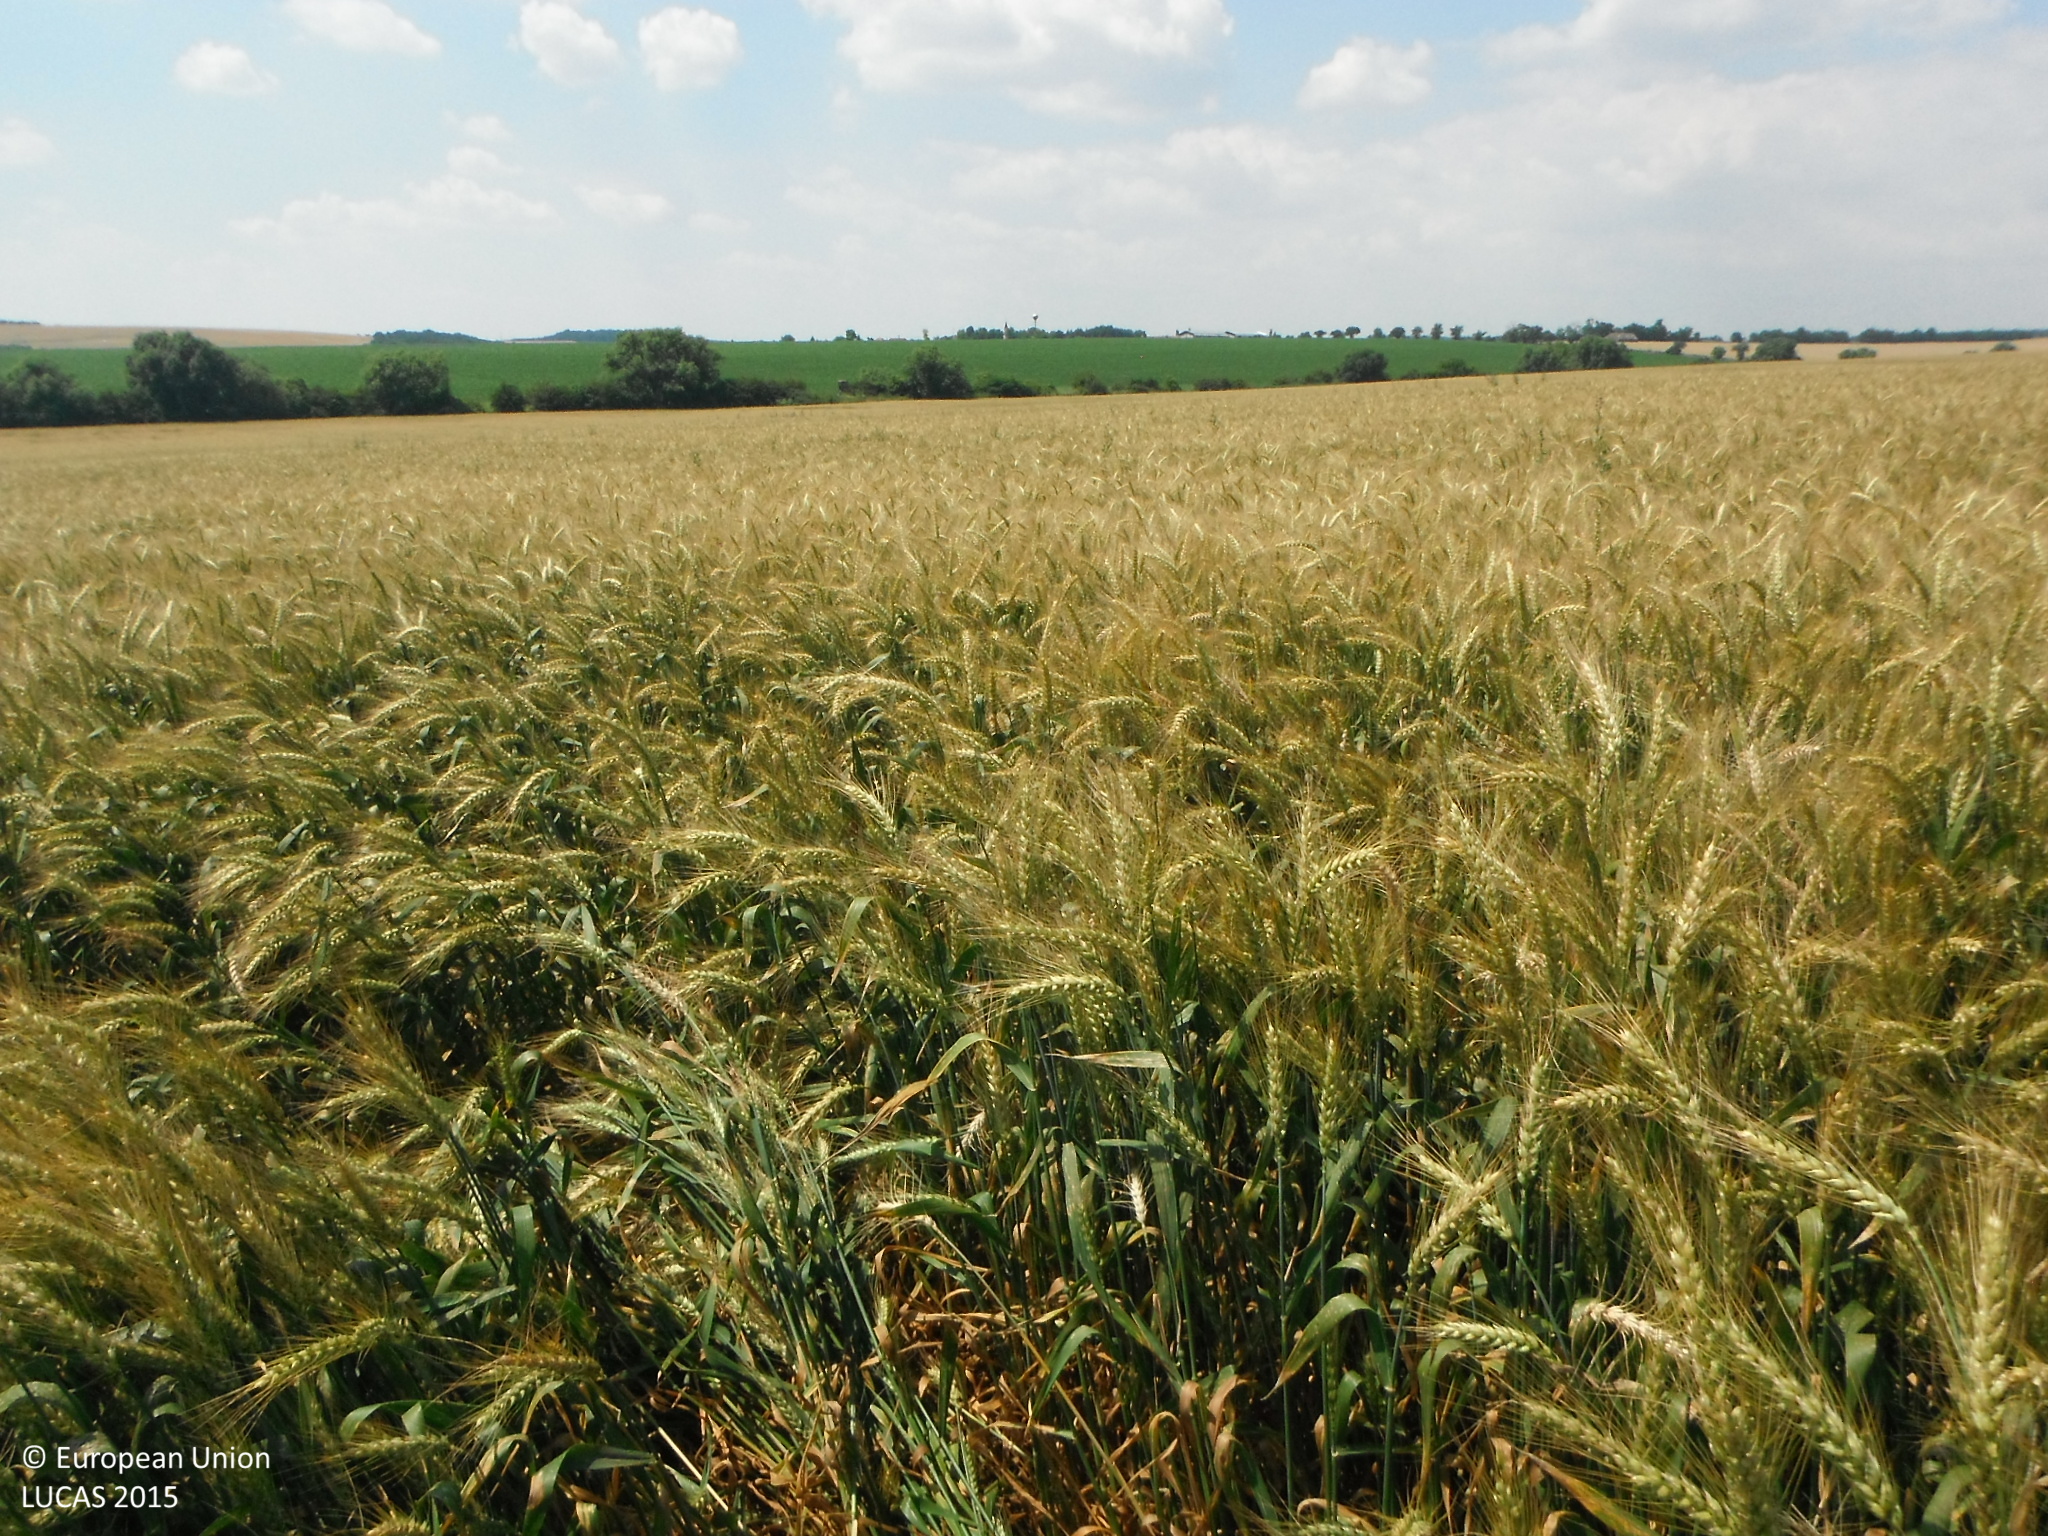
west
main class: Cropland
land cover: Common wheat
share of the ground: > 75 %
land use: Agriculture (excluding fallow land and kitchen gardens)
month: July
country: SK
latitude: 48.4444
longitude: 17.9215
